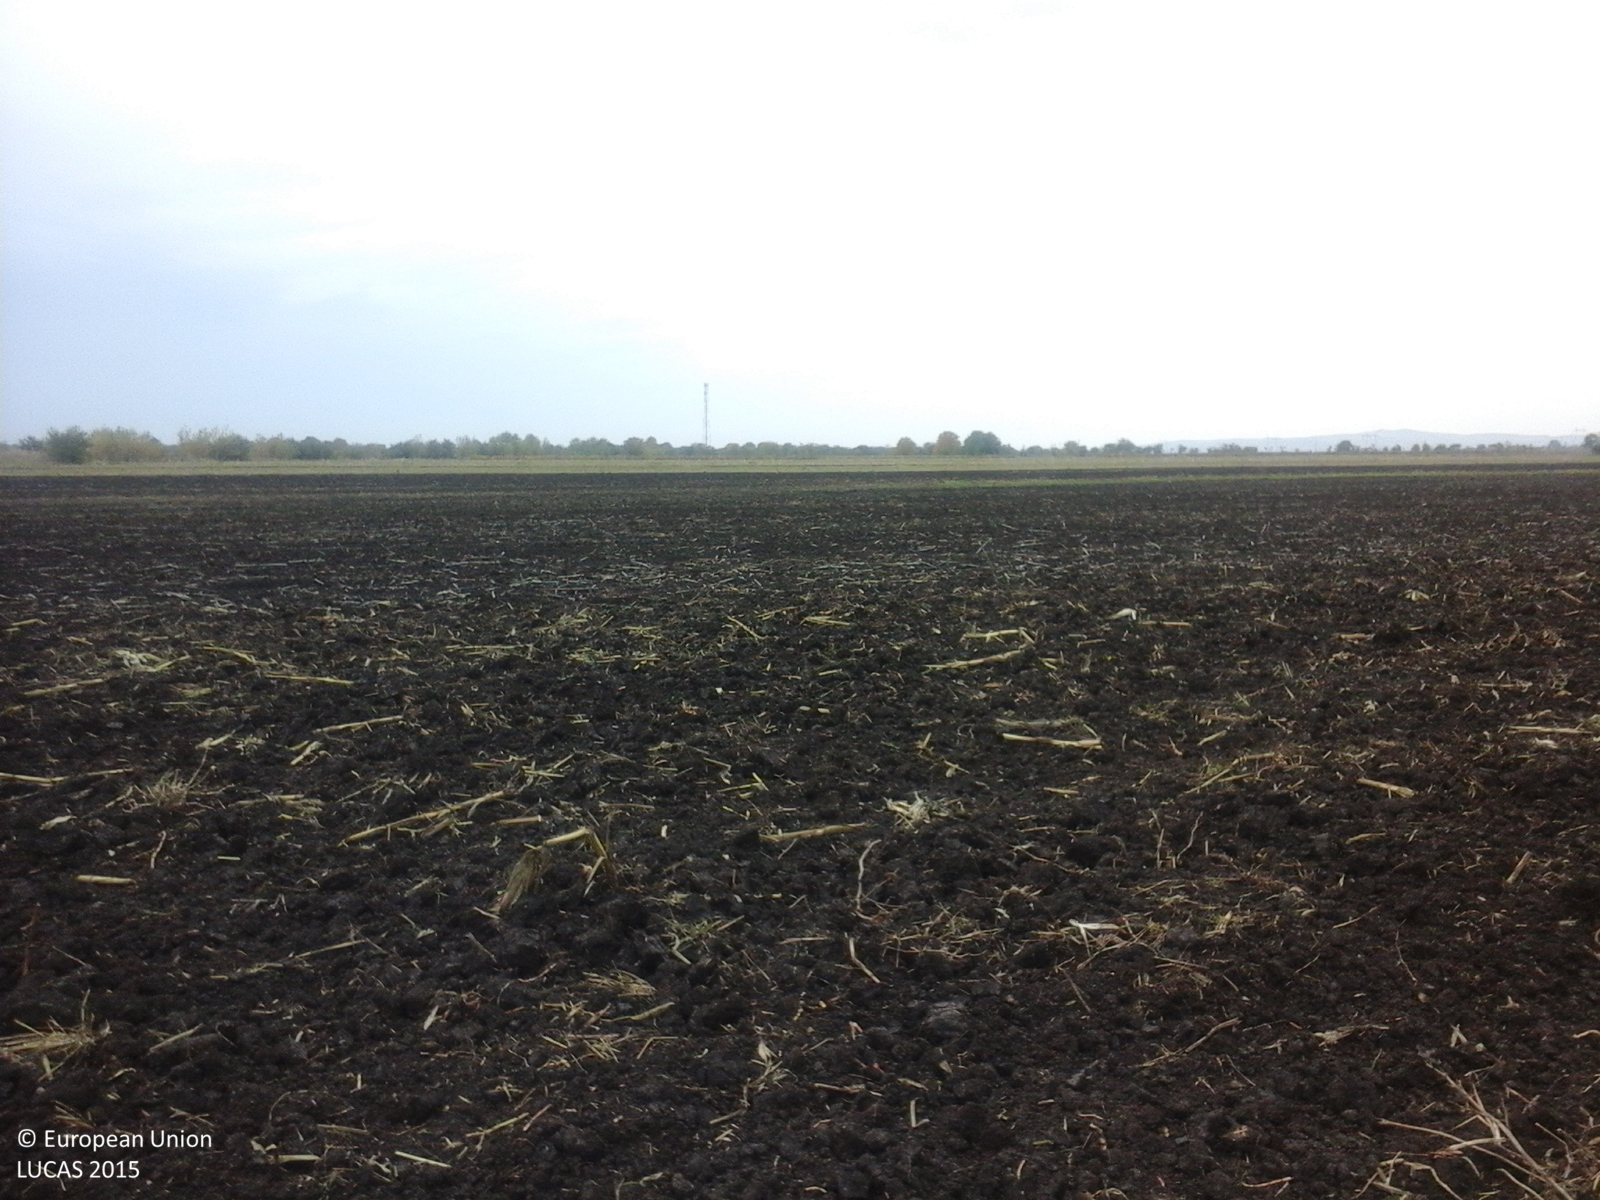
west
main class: Cropland
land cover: Maize
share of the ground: 10 - 25 %
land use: Agriculture (excluding fallow land and kitchen gardens)
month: October
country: RO
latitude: 44.9491
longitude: 26.3787
